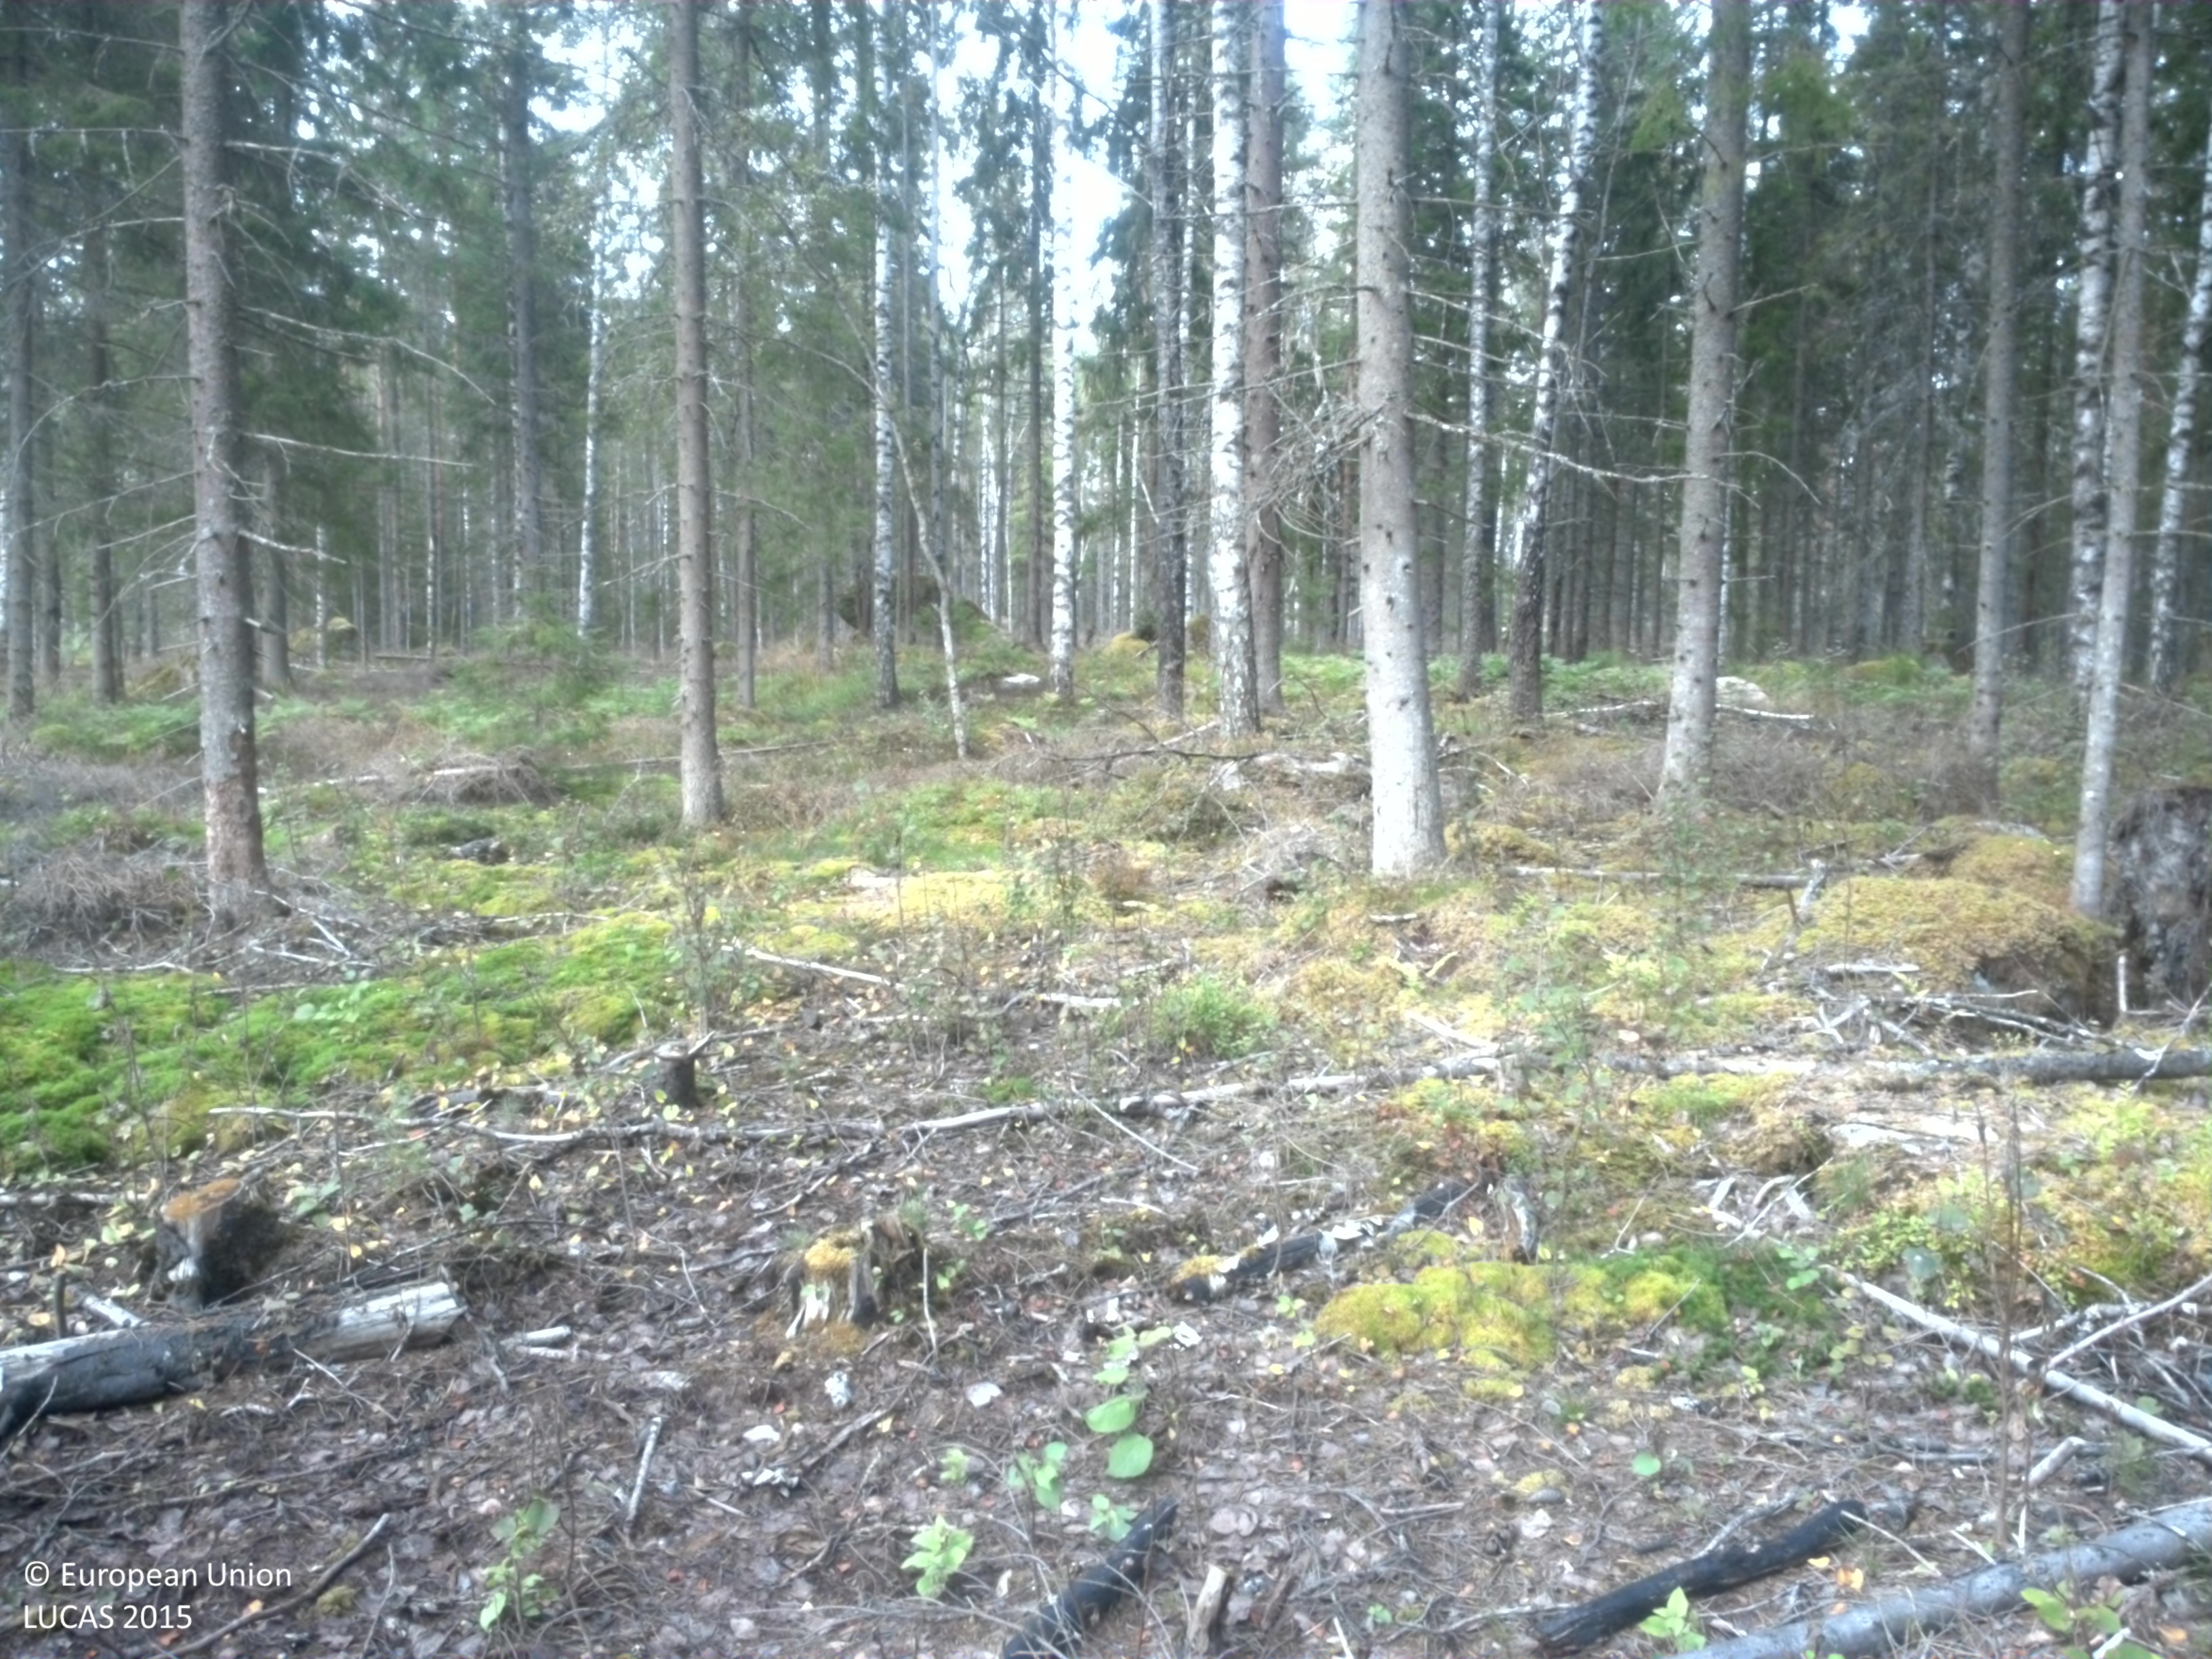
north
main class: Woodland
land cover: Spruce dominated mixed woodland
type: boreal forest
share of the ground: 50 - 75 %
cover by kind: coniferous forest trees 45 %, broadleaved forest trees 15 %, lichens and mosses 15 %, shrubs 10 %, herbaceous plants 10 %, unconsolidated bare surface 5 %
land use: Forestry
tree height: > 5 m
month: September
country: SE
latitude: 59.5075
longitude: 15.6627
